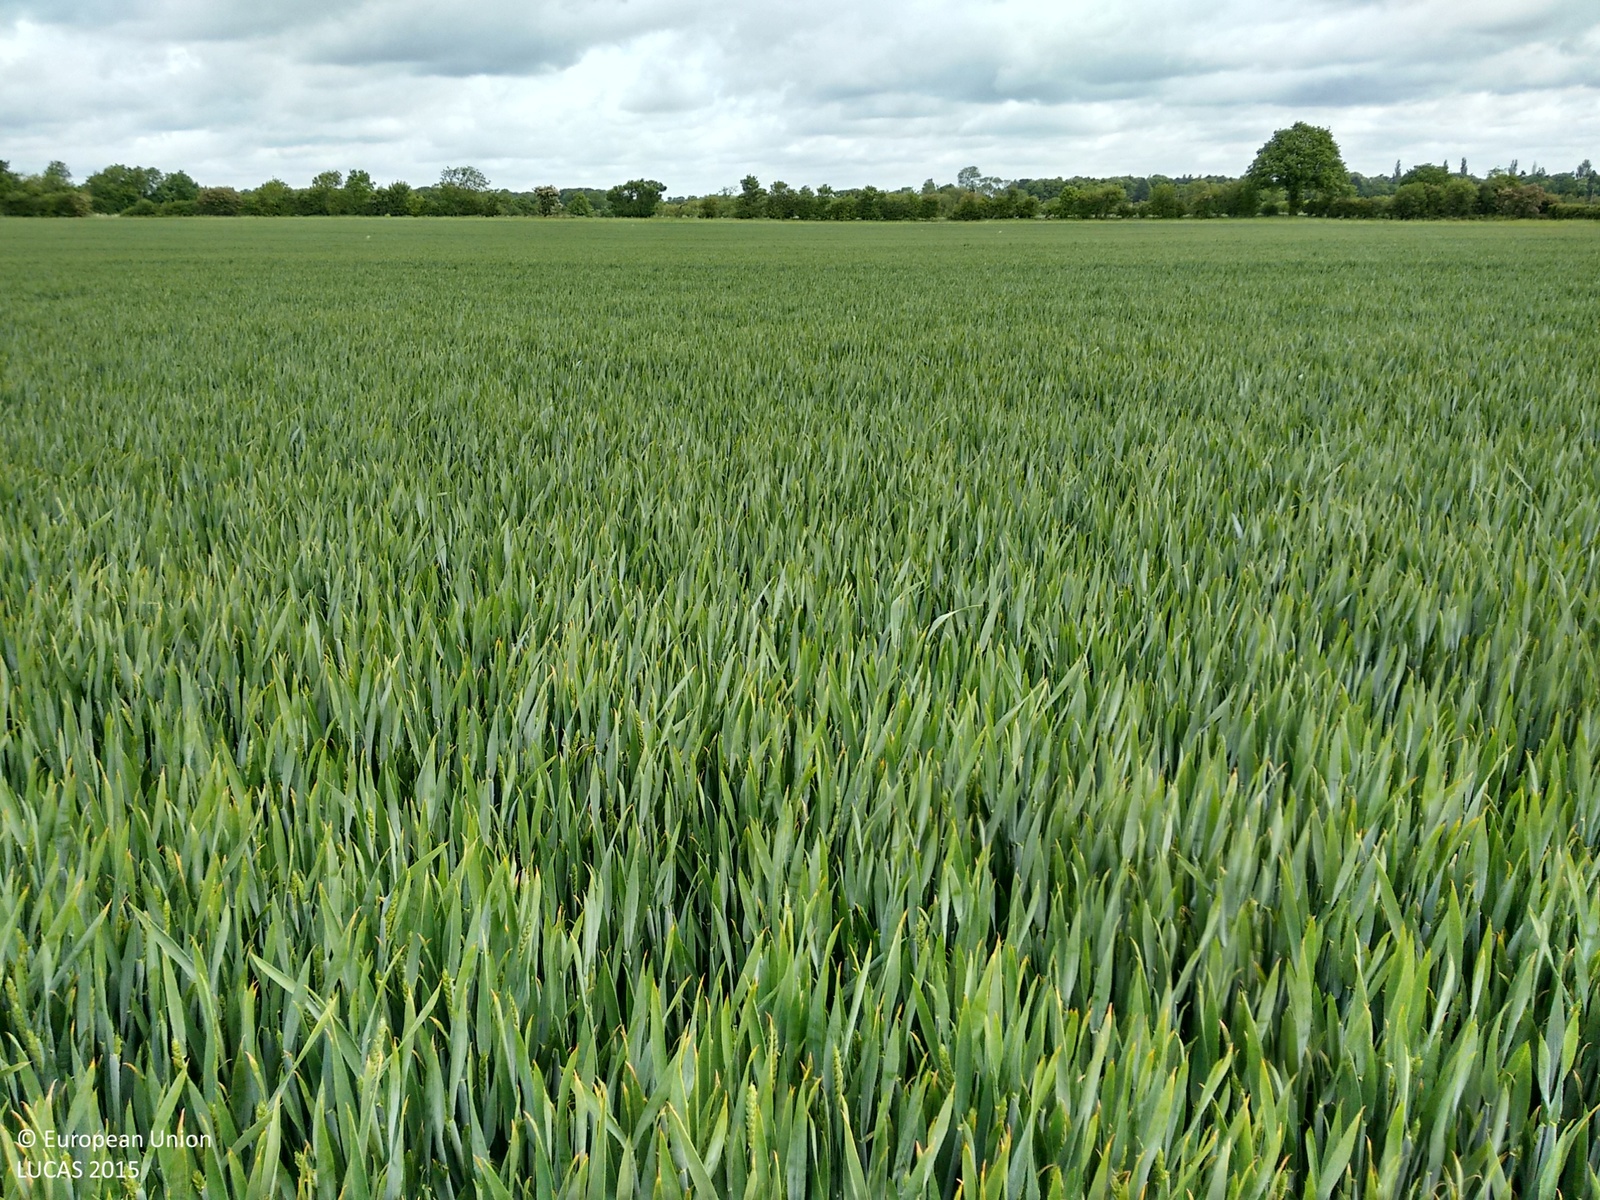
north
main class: Cropland
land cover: Common wheat
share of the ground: > 75 %
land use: Agriculture (excluding fallow land and kitchen gardens)
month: June
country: GB
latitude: 52.2135
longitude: -0.3547
